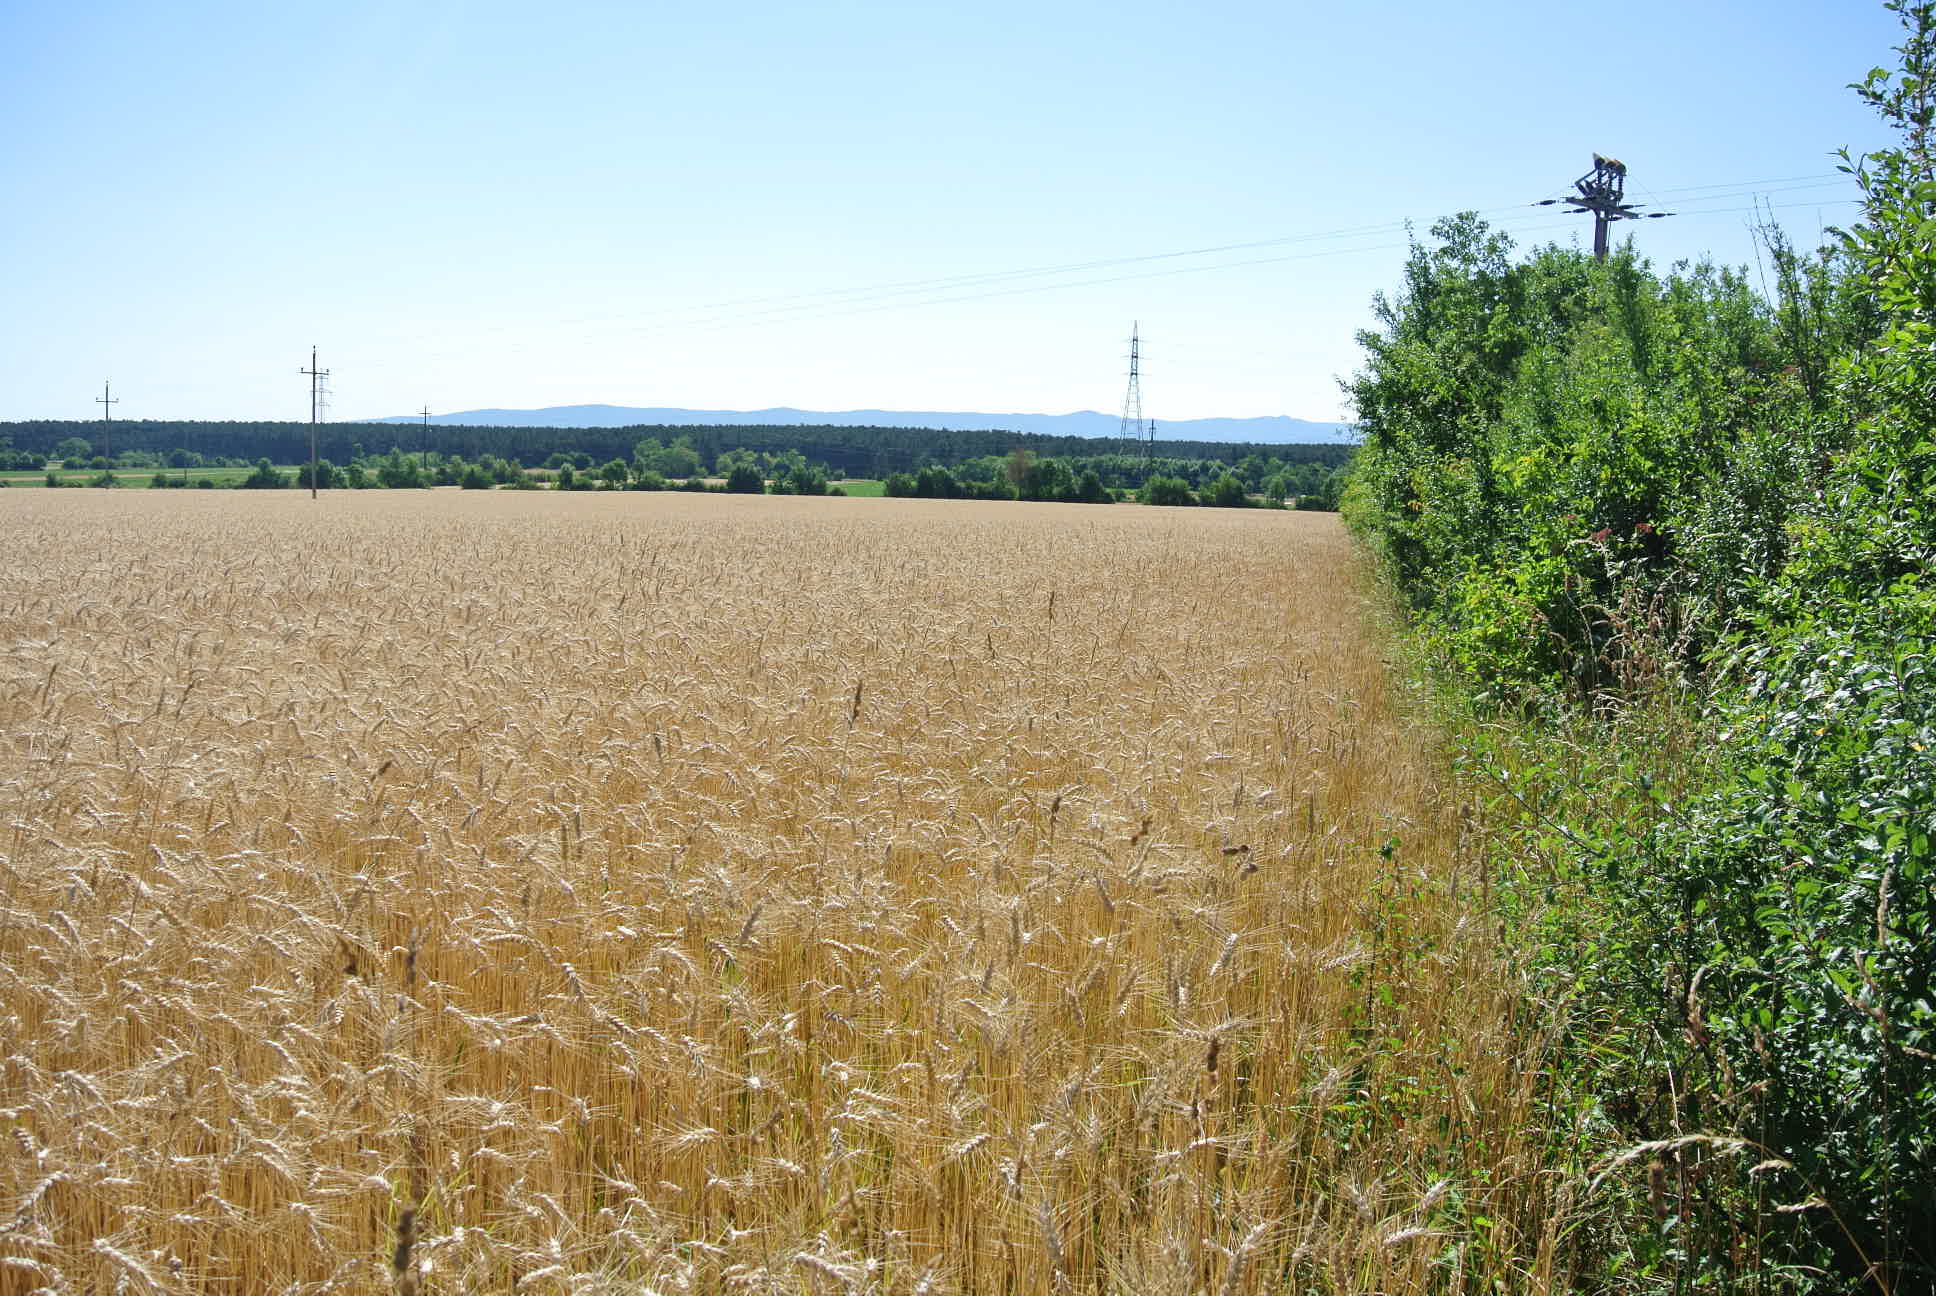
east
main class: Cropland
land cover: Durum wheat
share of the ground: > 75 %
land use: Agriculture (excluding fallow land and kitchen gardens)
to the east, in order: Durum wheat; Electric lines; Durum wheat
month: July
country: AT
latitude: 47.7658
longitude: 16.1006
